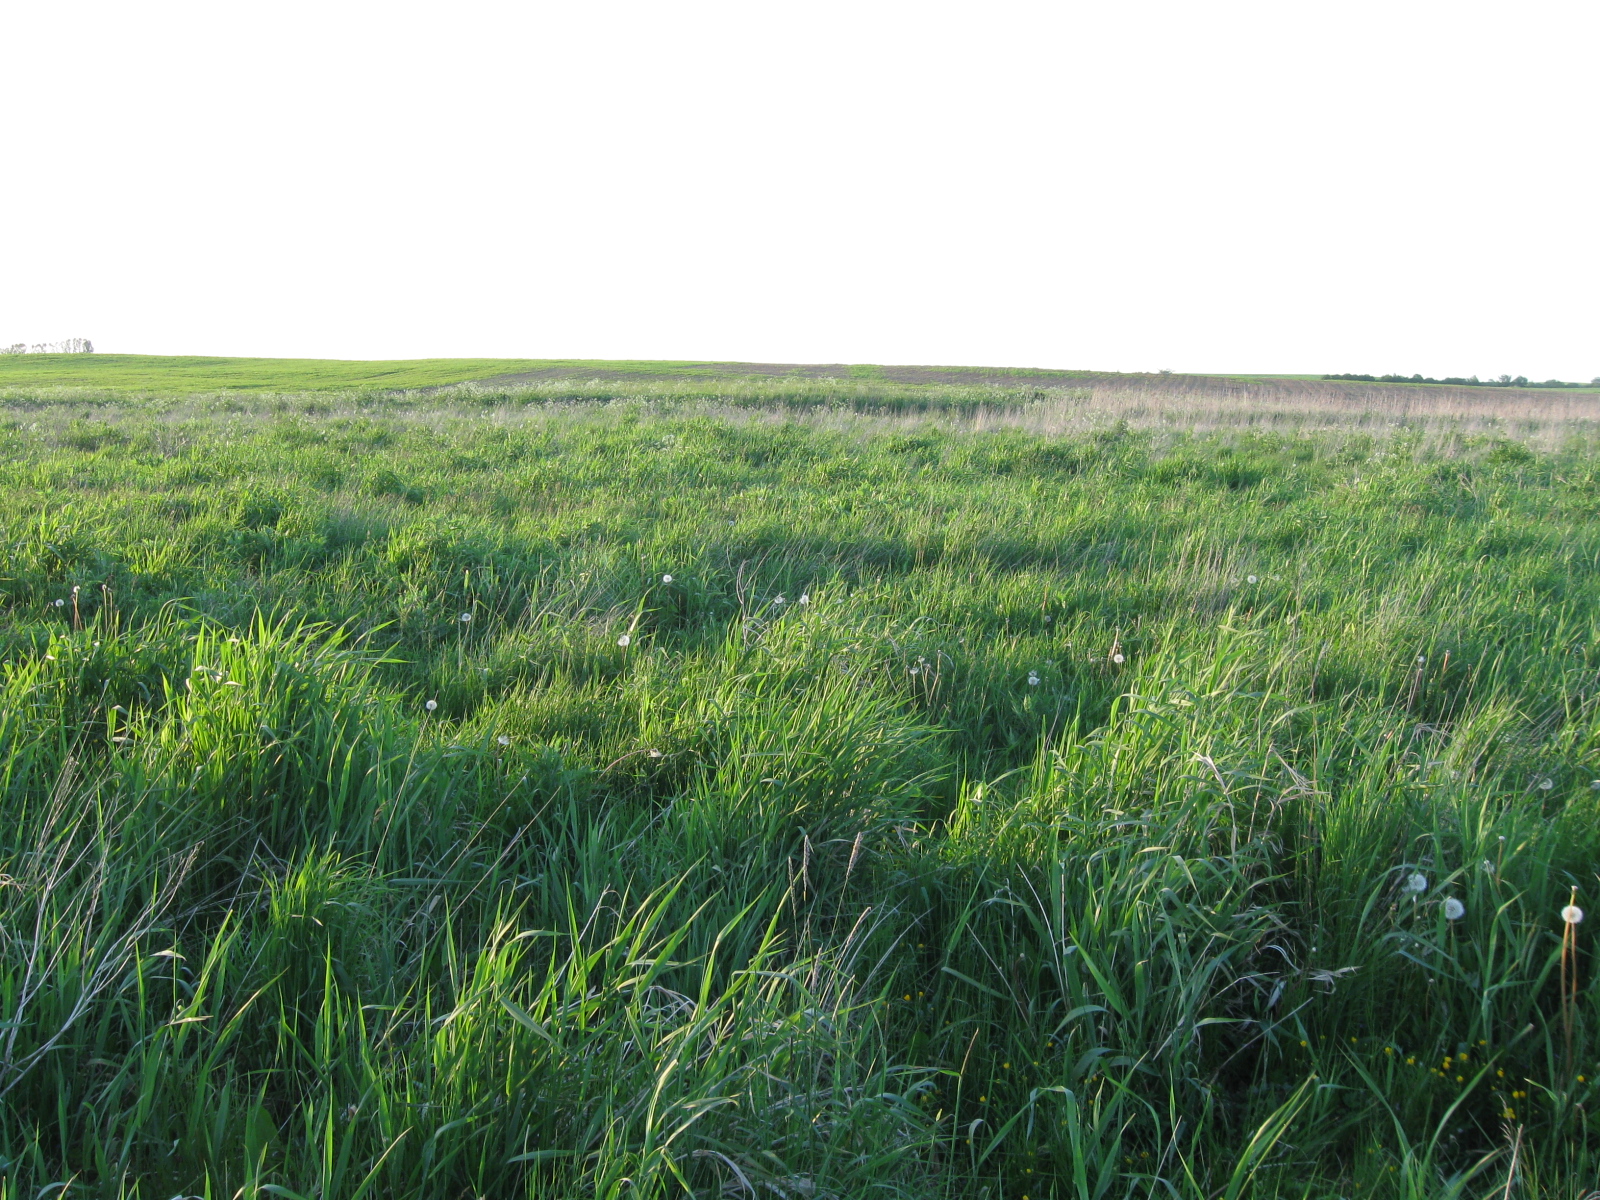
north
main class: Grassland
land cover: Grassland without tree/shrub cover
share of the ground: > 75 %
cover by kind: herbaceous plants 100 %
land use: Agriculture (excluding fallow land and kitchen gardens)
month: May
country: LT
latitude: 54.5596
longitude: 22.7955
